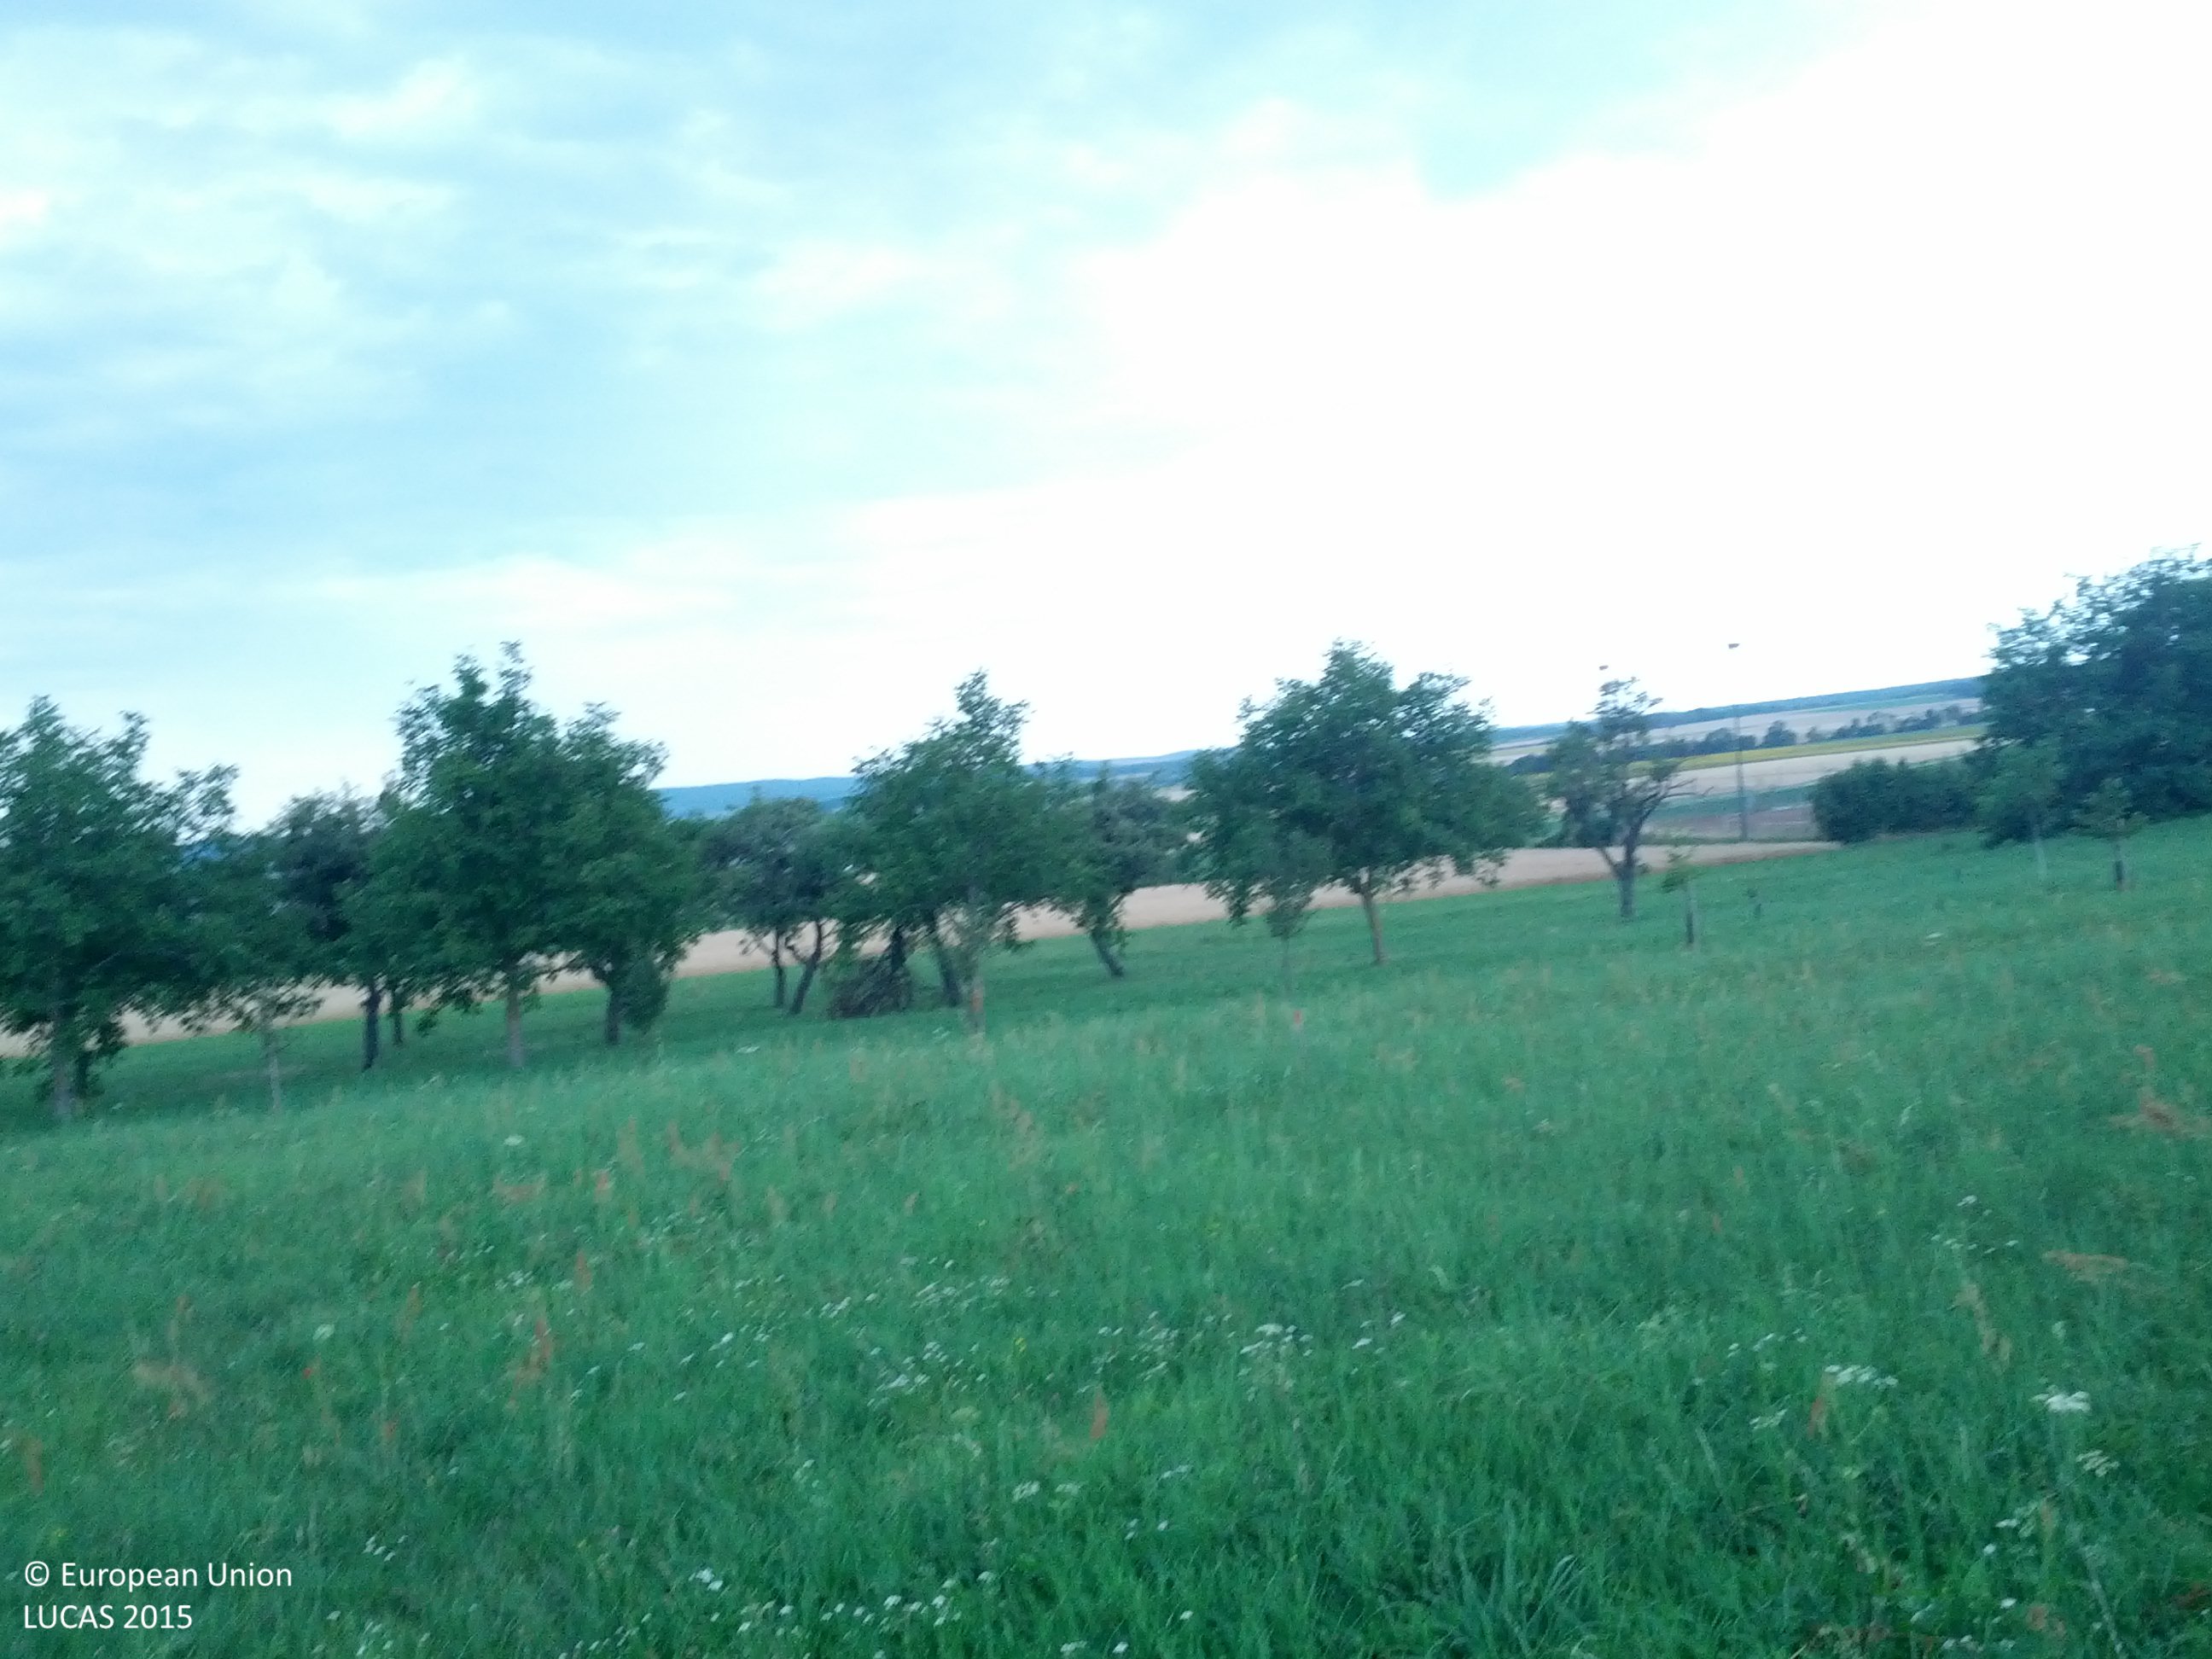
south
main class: Cropland
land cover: Common wheat
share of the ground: 10 - 25 %
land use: Agriculture (excluding fallow land and kitchen gardens)
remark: Harvested field
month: July
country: AT
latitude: 47.2979
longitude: 16.3904
